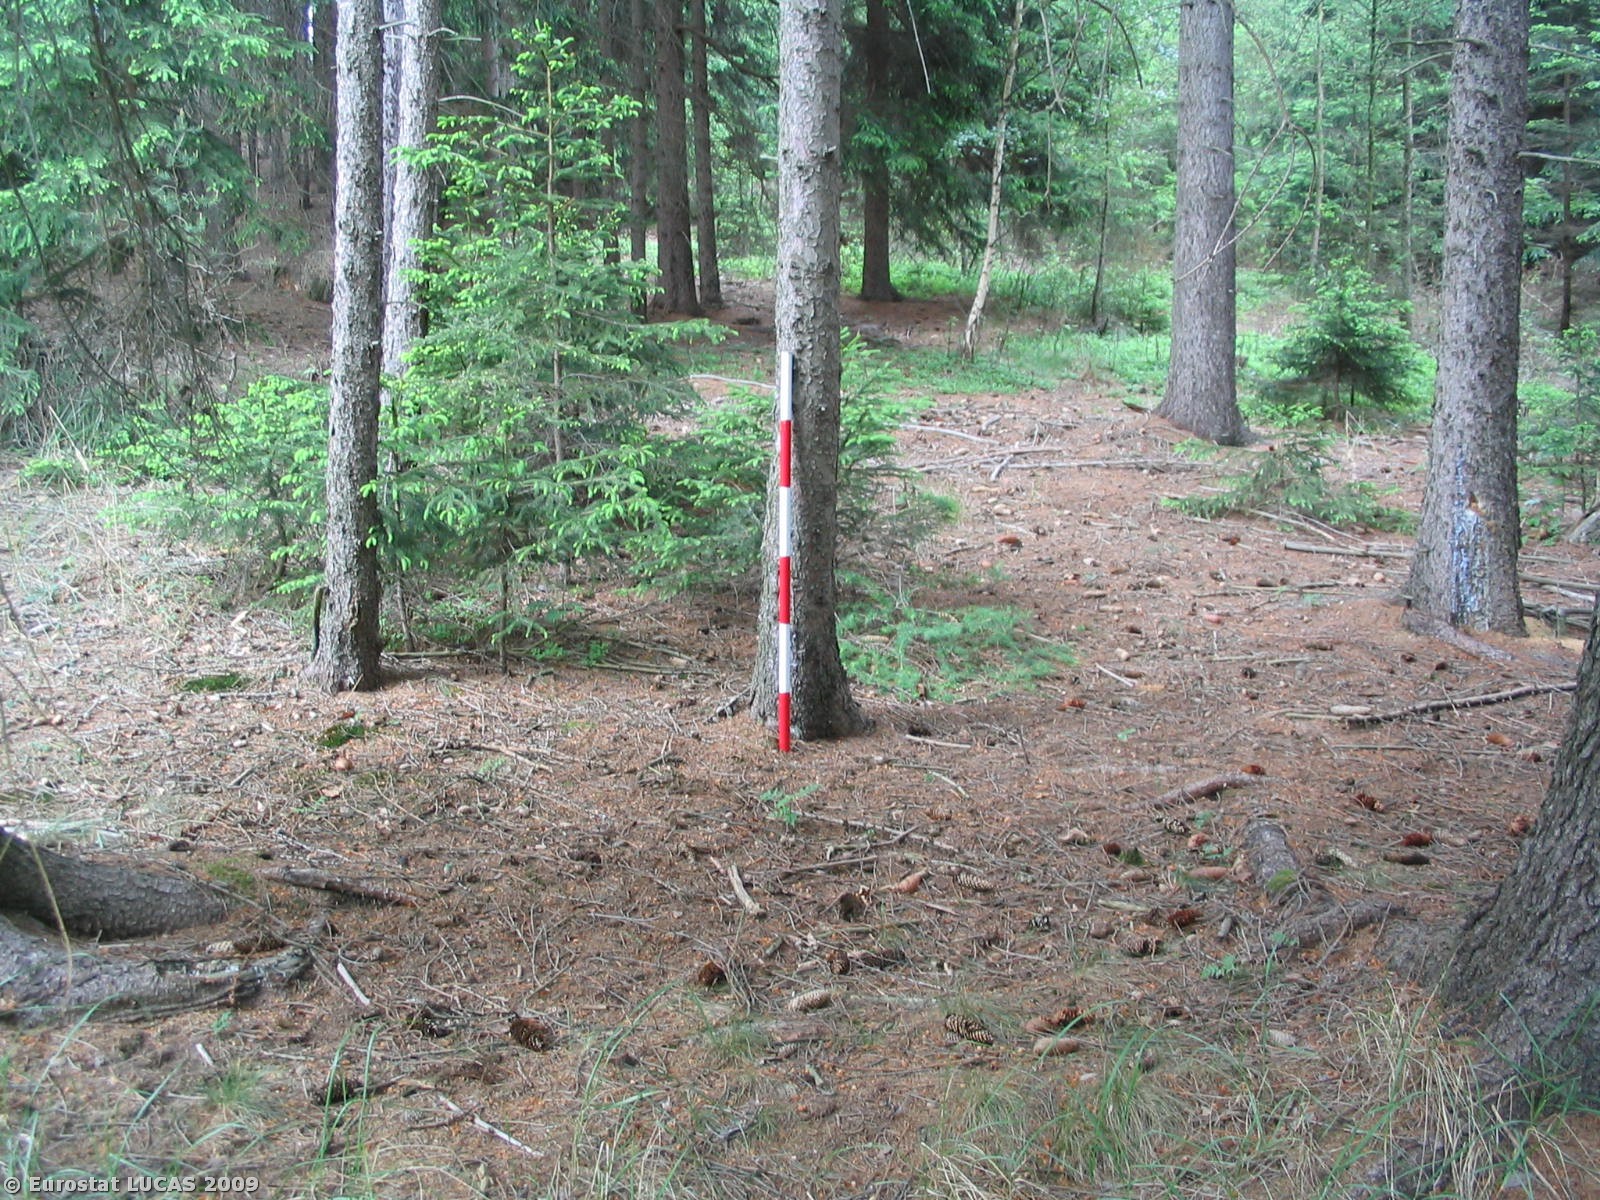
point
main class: Woodland
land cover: Coniferous woodland
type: hemiboreal forest and nemoral coniferous forest and mixed broadleaved-coniferous forest
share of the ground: > 75 %
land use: Forestry
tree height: > 5 m
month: May
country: CZ
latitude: 49.4409
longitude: 16.4752
